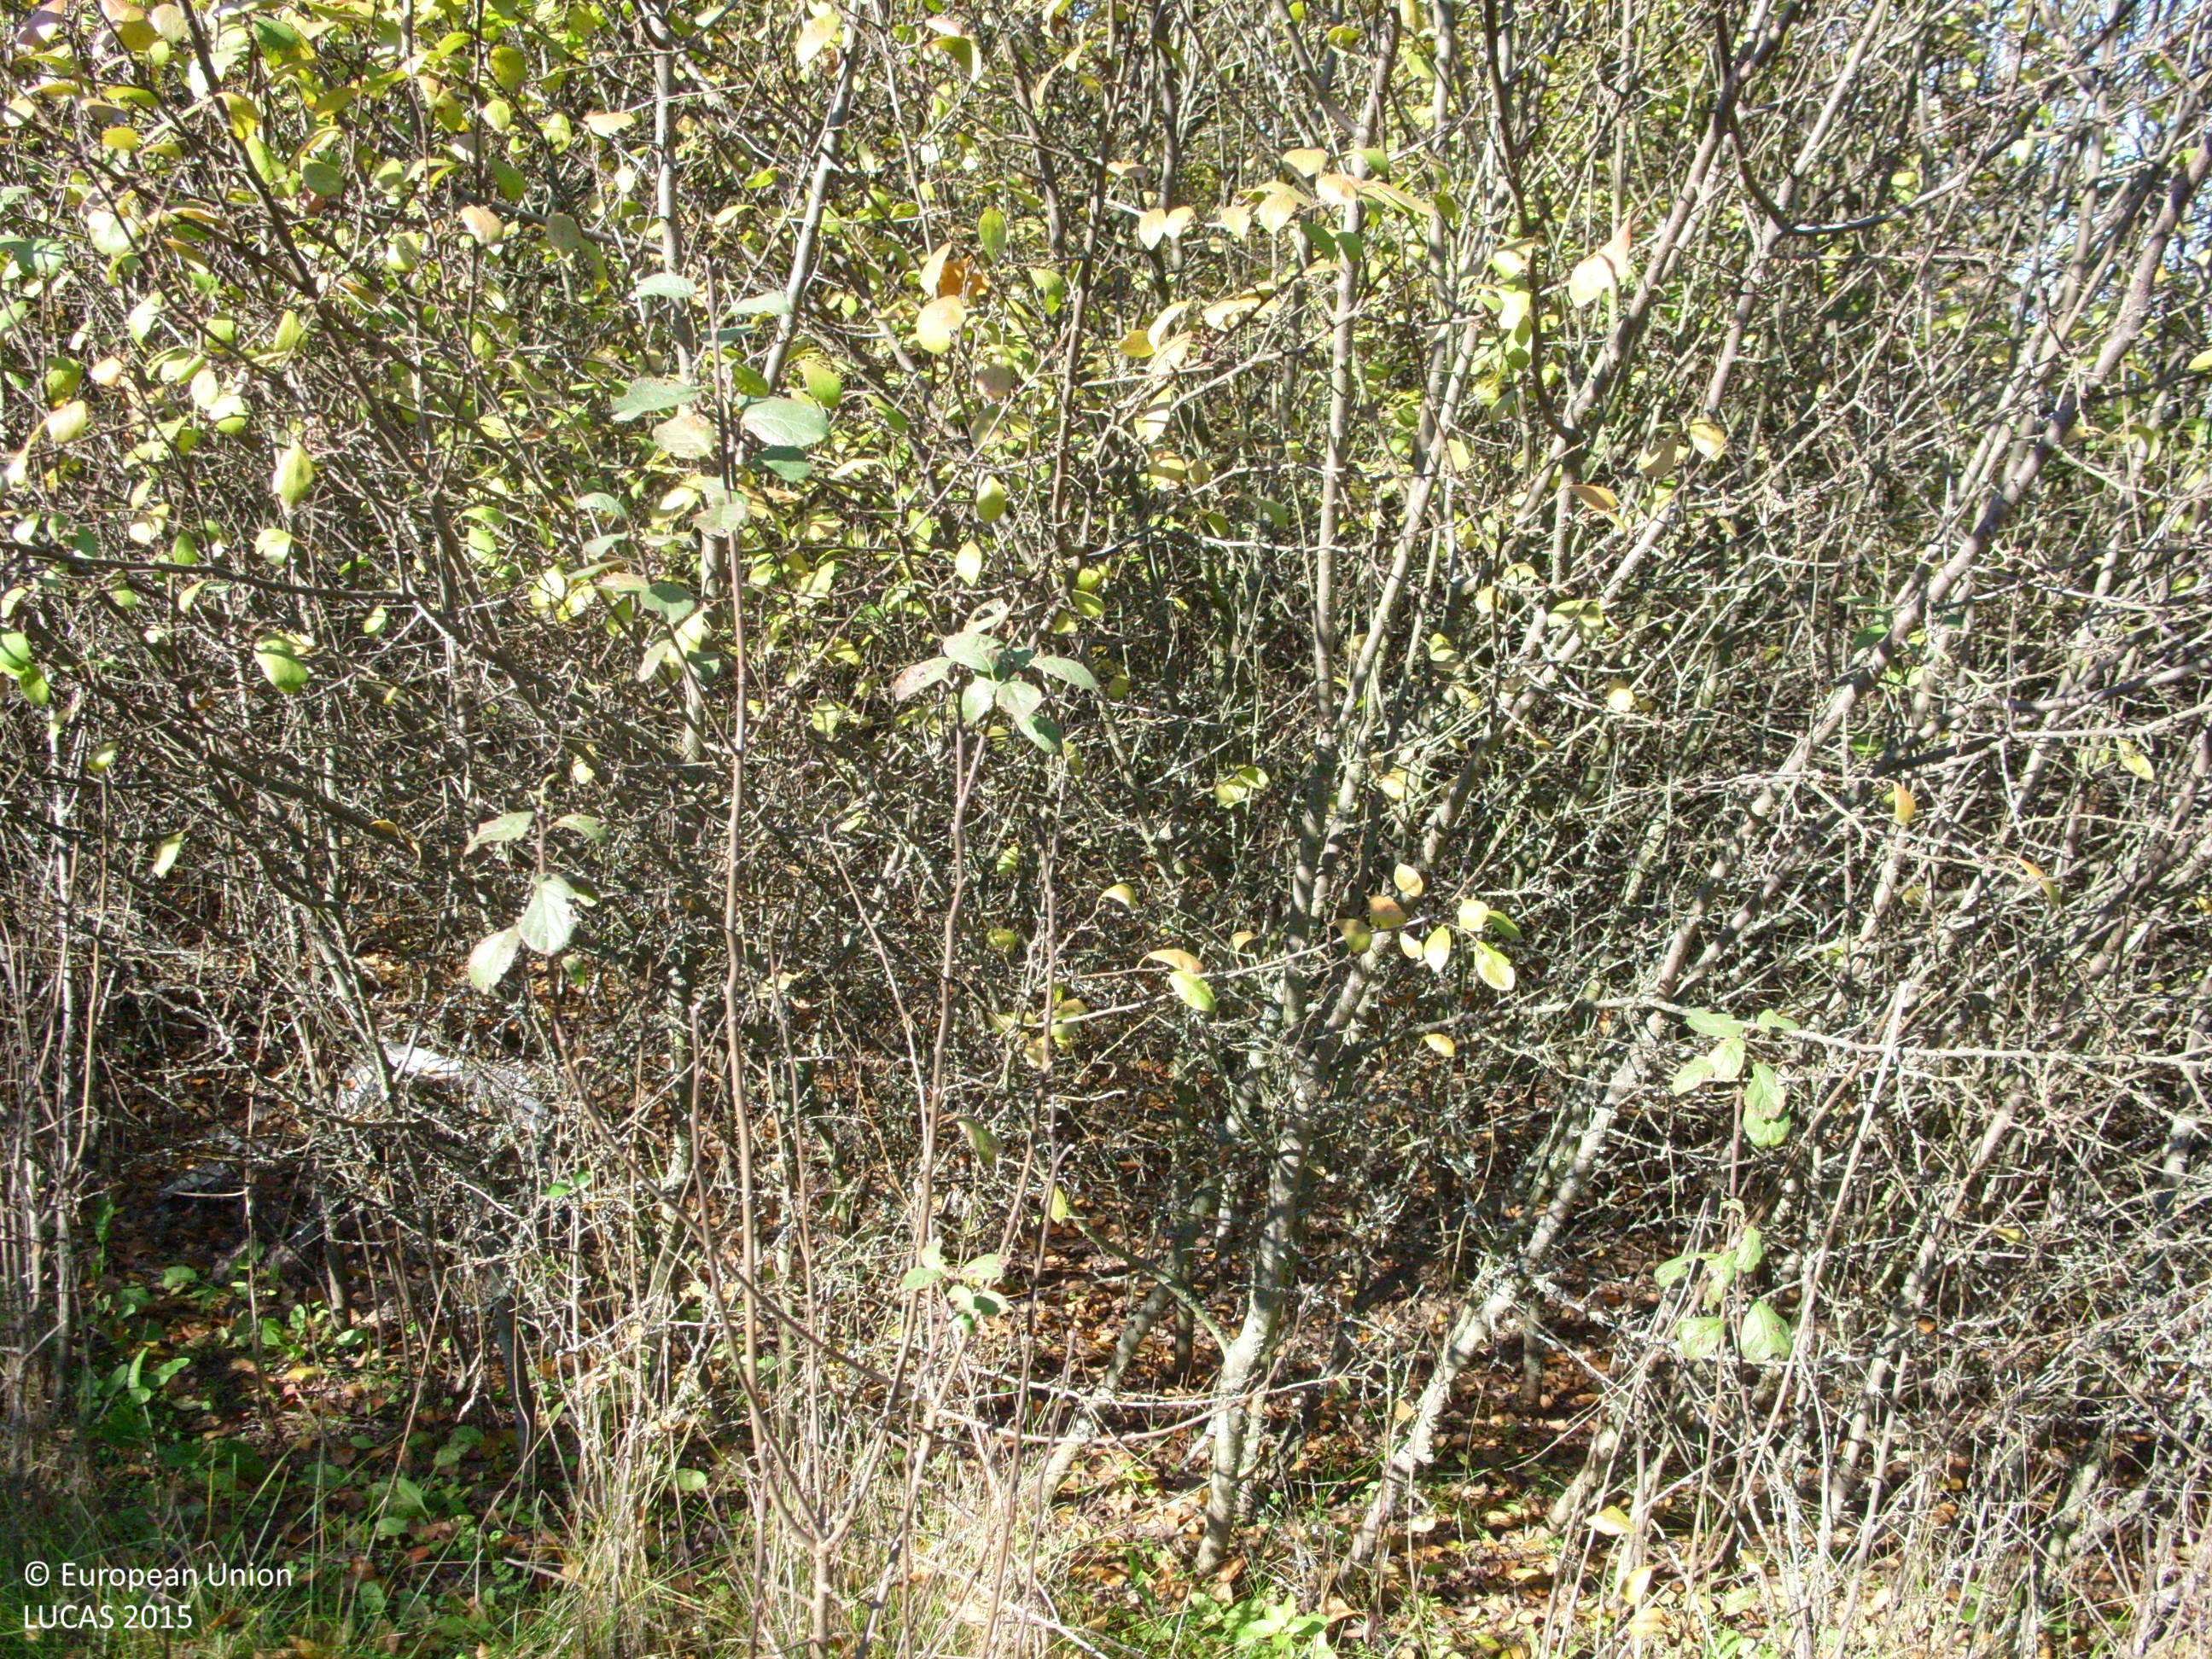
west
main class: Shrubland
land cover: Shrubland with sparse tree cover
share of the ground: > 75 %
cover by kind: shrubs 80 %, herbaceous plants 15 %, broadleaved forest trees 5 %
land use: Abandoned areas
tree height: < 5 m
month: November
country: BG
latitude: 42.3226
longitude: 24.9706
